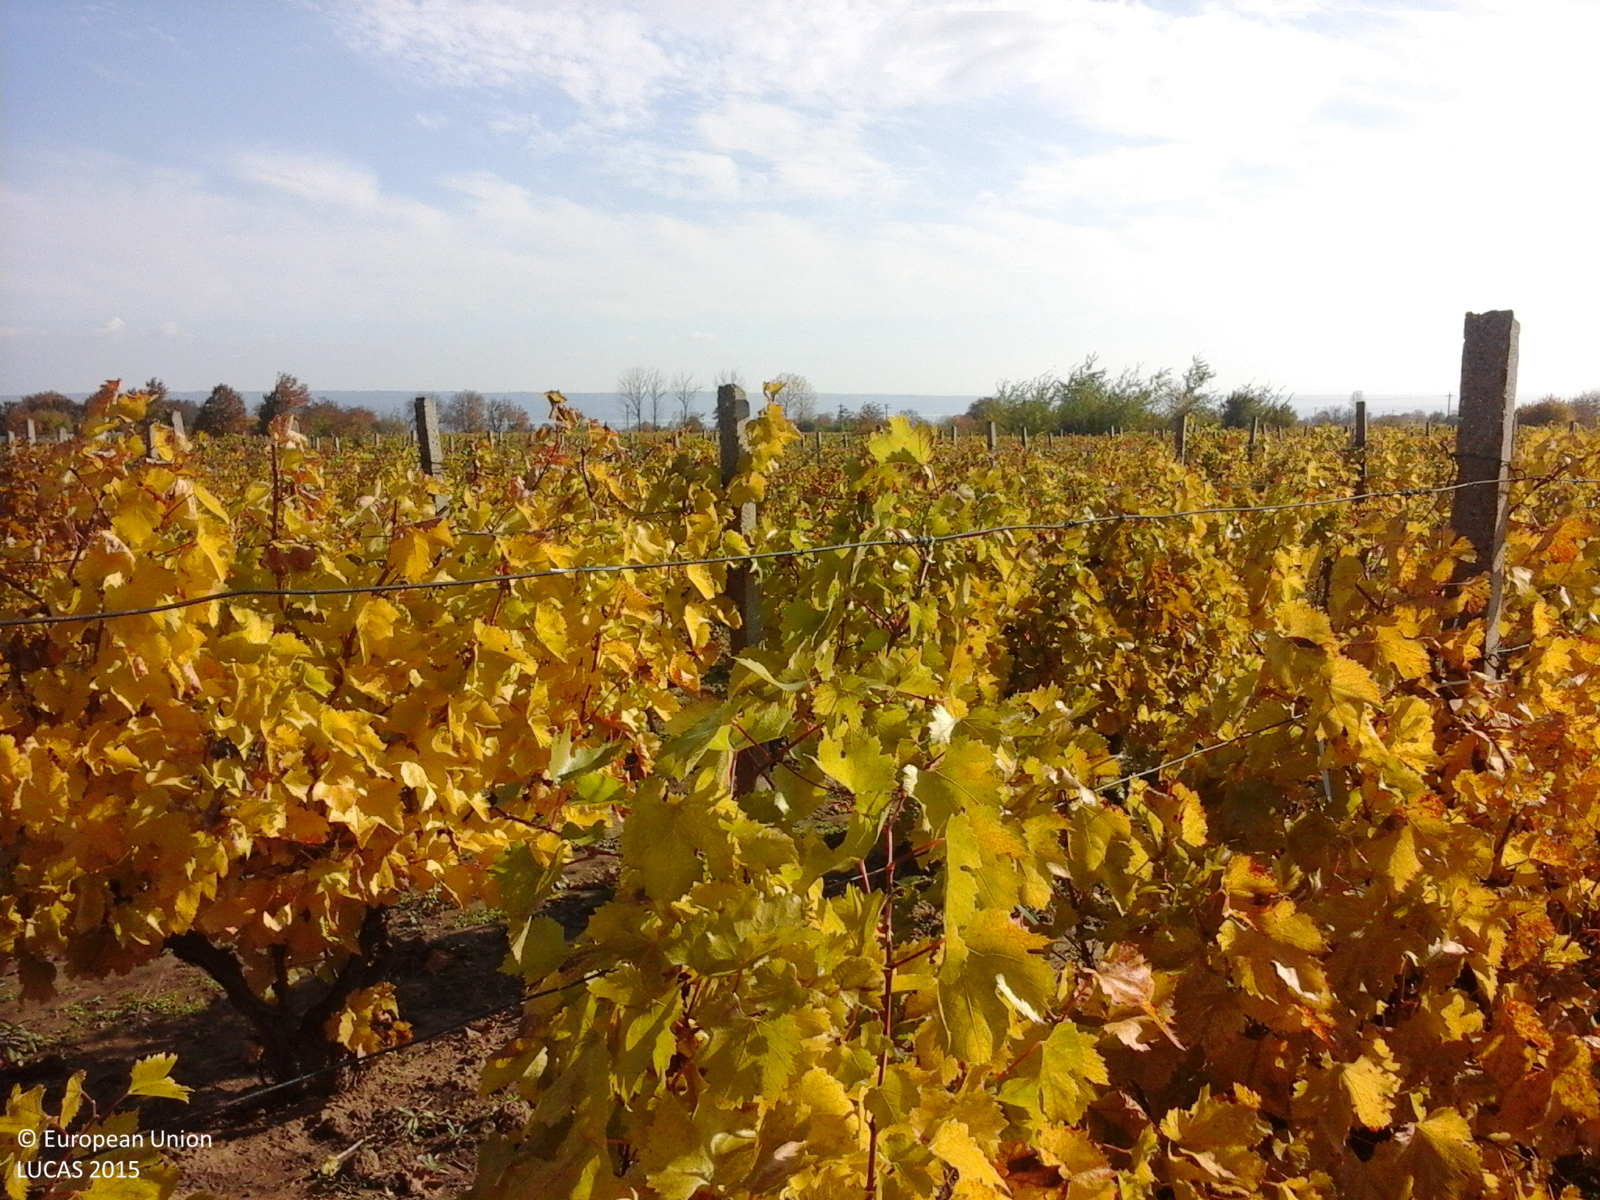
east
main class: Cropland
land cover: Vineyards
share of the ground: > 75 %
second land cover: Grassland without tree/shrub cover
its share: 25 - 50 %
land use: Agriculture (excluding fallow land and kitchen gardens)
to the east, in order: Vineyards; Grassland without tree/shrub cover; Tracks; Grass margins; Vineyards; Grass margins; Tracks; Grass margins; Vineyards; Grass margins; Tracks; Grass margins; Vineyards
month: October
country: RO
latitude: 45.9740
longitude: 27.0922
